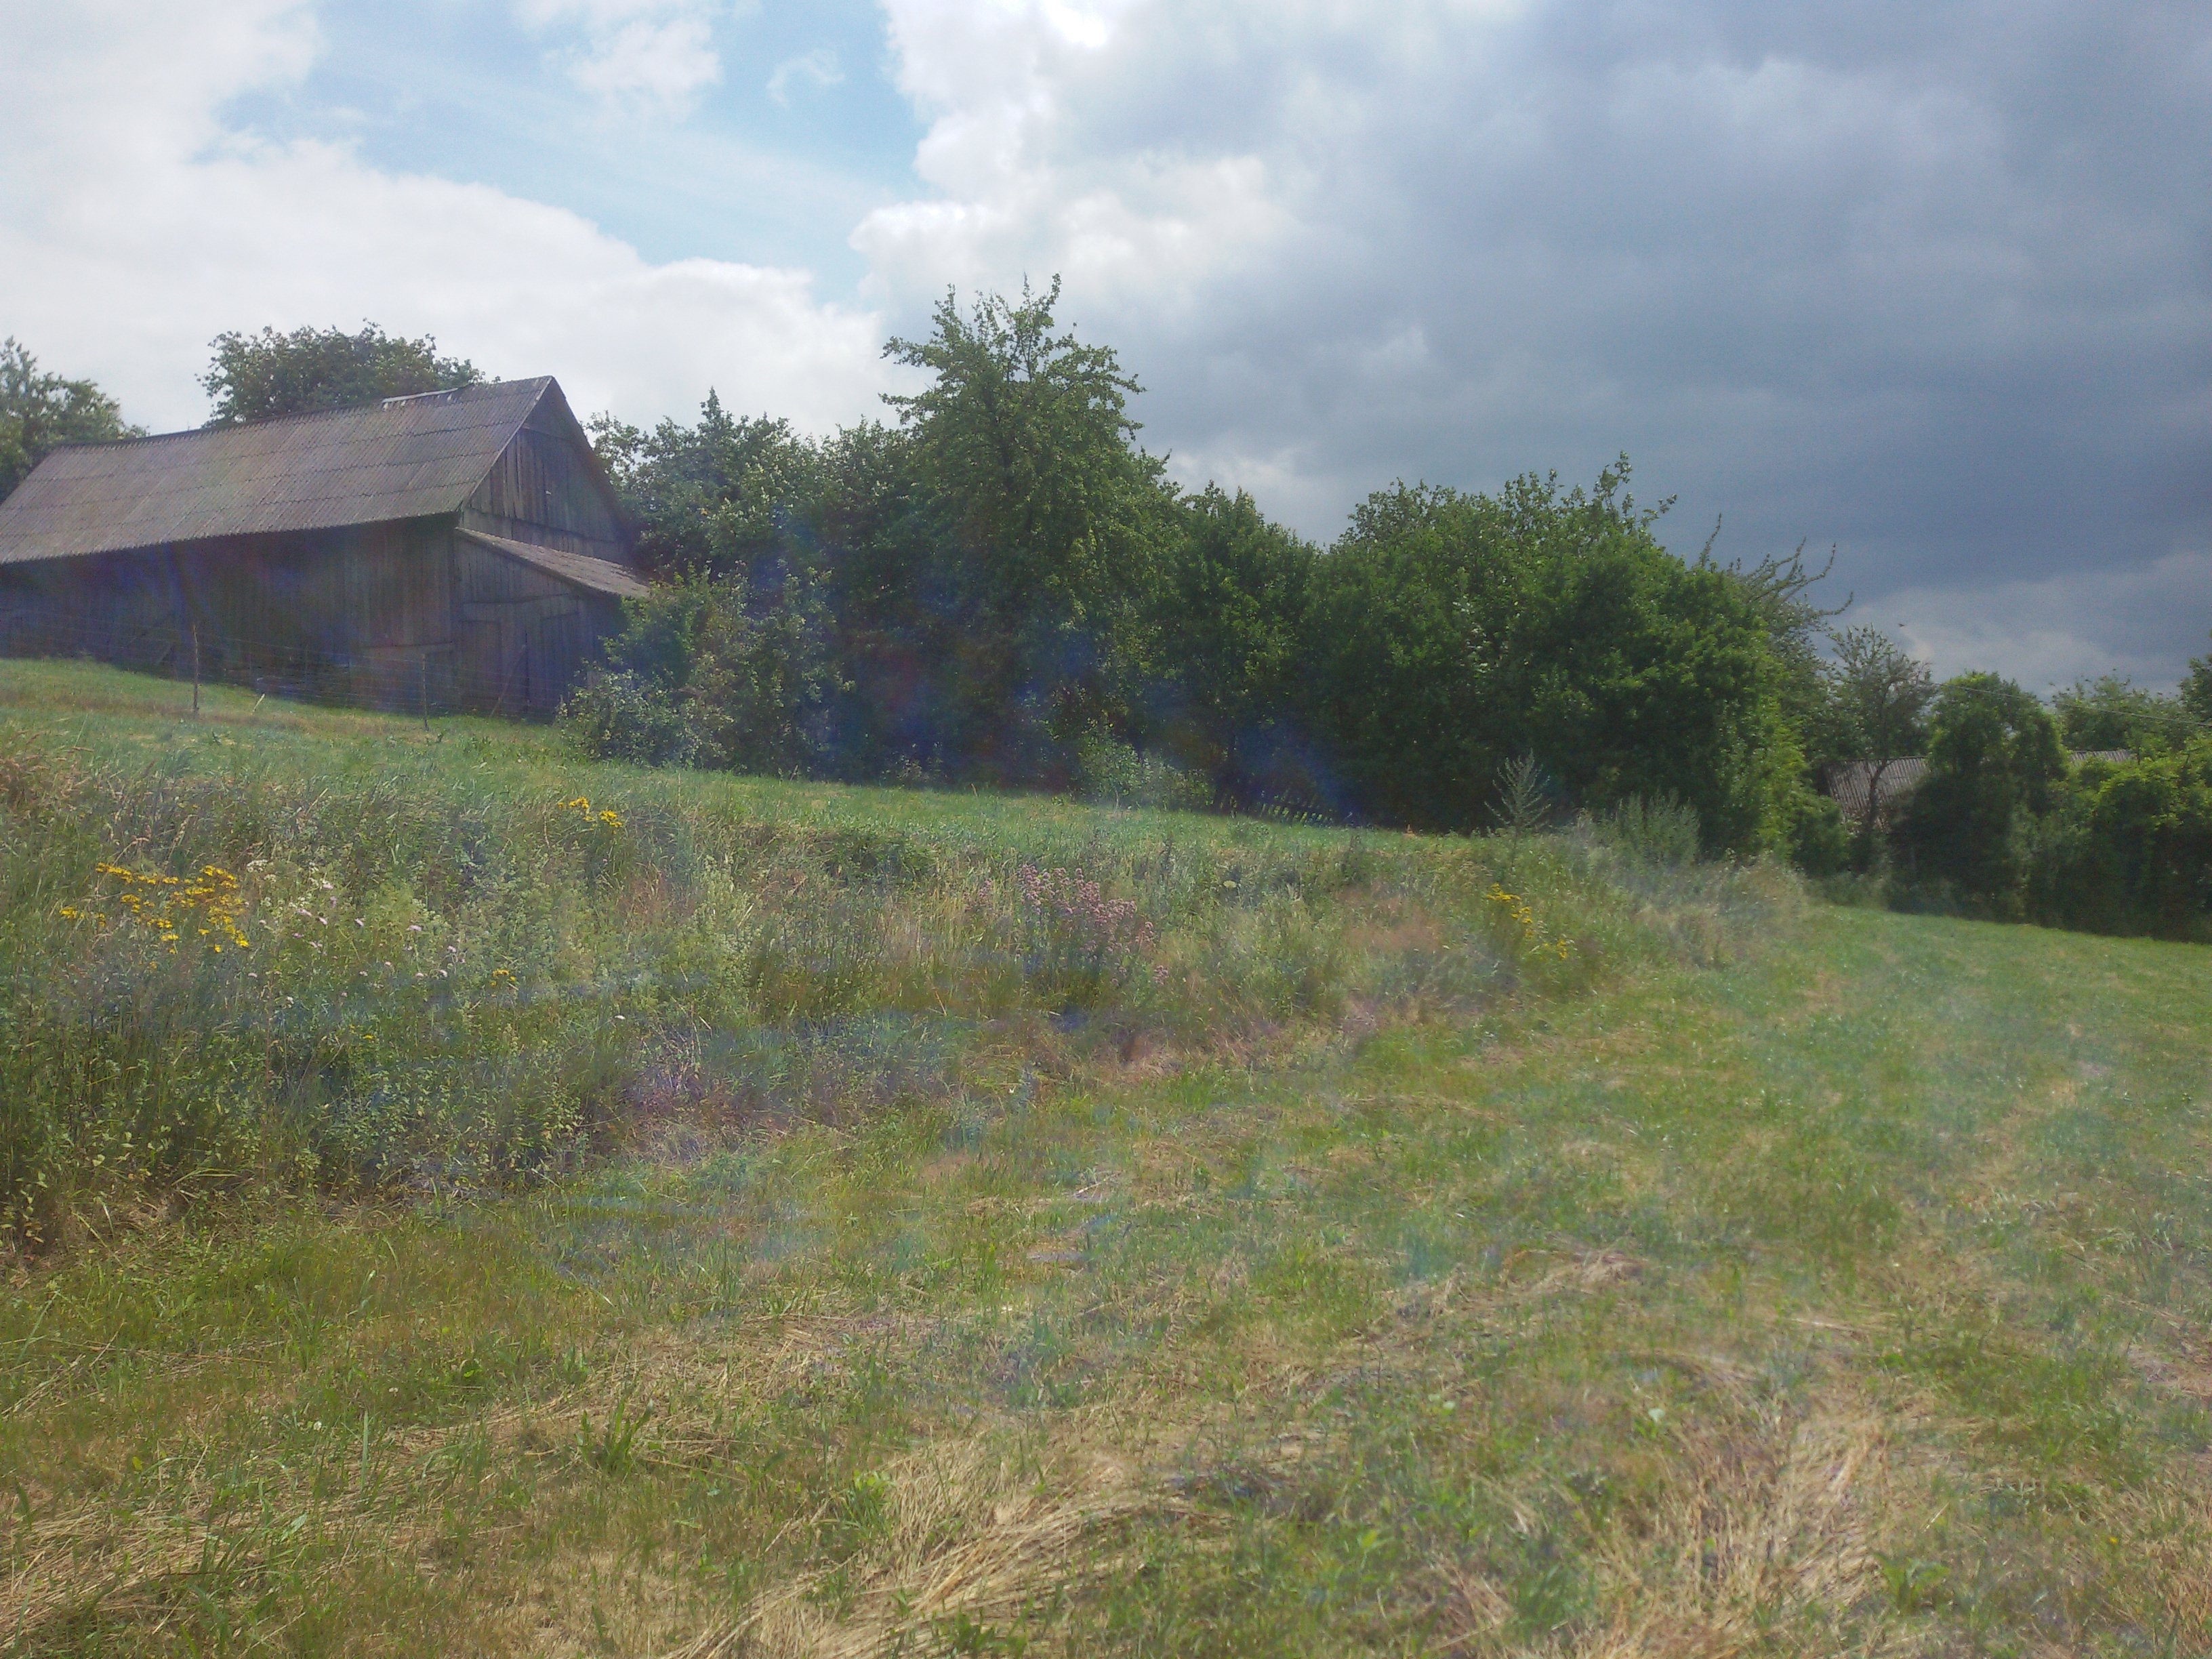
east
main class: Grassland
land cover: Grassland without tree/shrub cover
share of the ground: > 75 %
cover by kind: herbaceous plants 100 %
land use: Agriculture (excluding fallow land and kitchen gardens)
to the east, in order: Grassland without tree/shrub cover; Spontaneously vegetated surfaces; Grassland without tree/shrub cover; Broadleaved woodland; Artificial constructions in urban areas; Grassland without tree/shrub cover; Pine dominated mixed woodland; Grassland without tree/shrub cover; Single bushes/trees; Grassland without tree/shrub cover
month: July
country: PL
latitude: 49.7735
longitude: 22.2667
